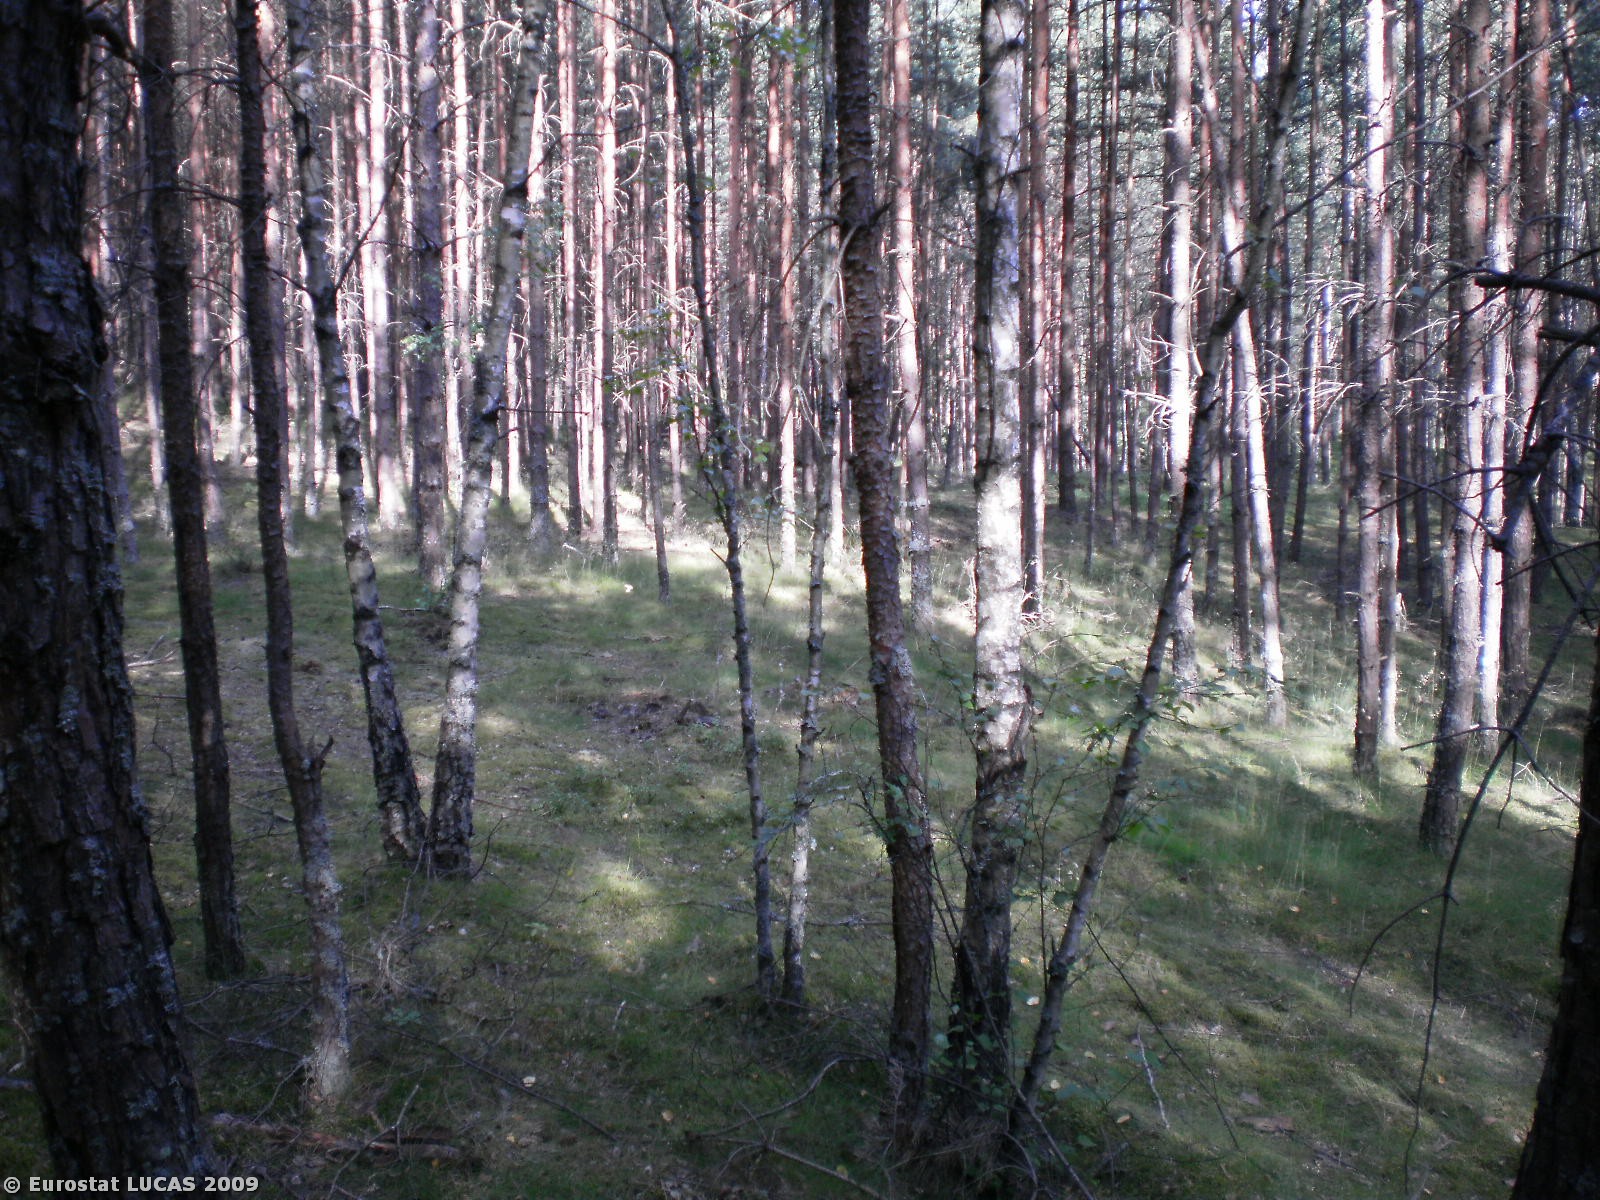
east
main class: Woodland
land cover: Coniferous woodland
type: hemiboreal forest and nemoral coniferous forest and mixed broadleaved-coniferous forest
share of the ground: > 75 %
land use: Forestry
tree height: > 5 m
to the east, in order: Coniferous woodland; Shrubland with sparse tree cover; Grass margins; Tracks; Grass margins; Electric lines; Grass margins; Shrubland without tree cover
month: July
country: PL
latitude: 54.0362
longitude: 17.7846
